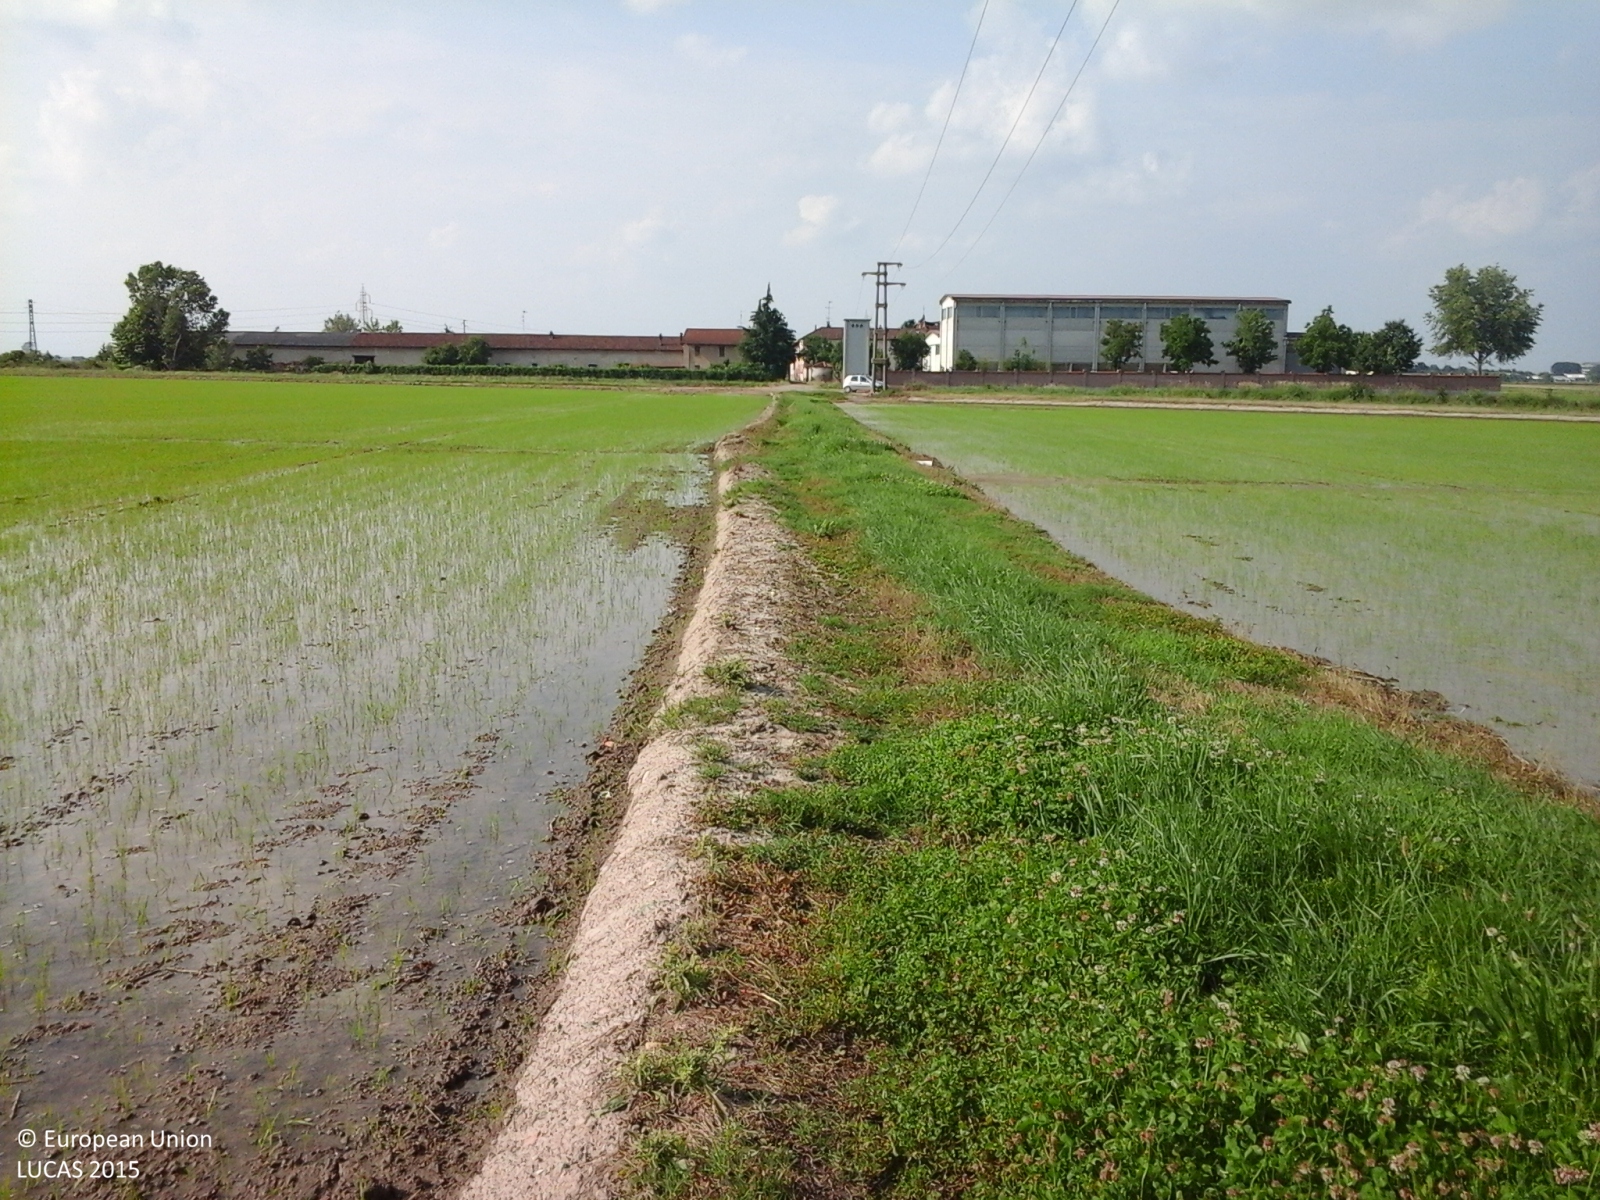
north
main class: Cropland
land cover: Rice
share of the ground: 25 - 50 %
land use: Agriculture (excluding fallow land and kitchen gardens)
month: May
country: IT
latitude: 45.3298
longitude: 8.3824
